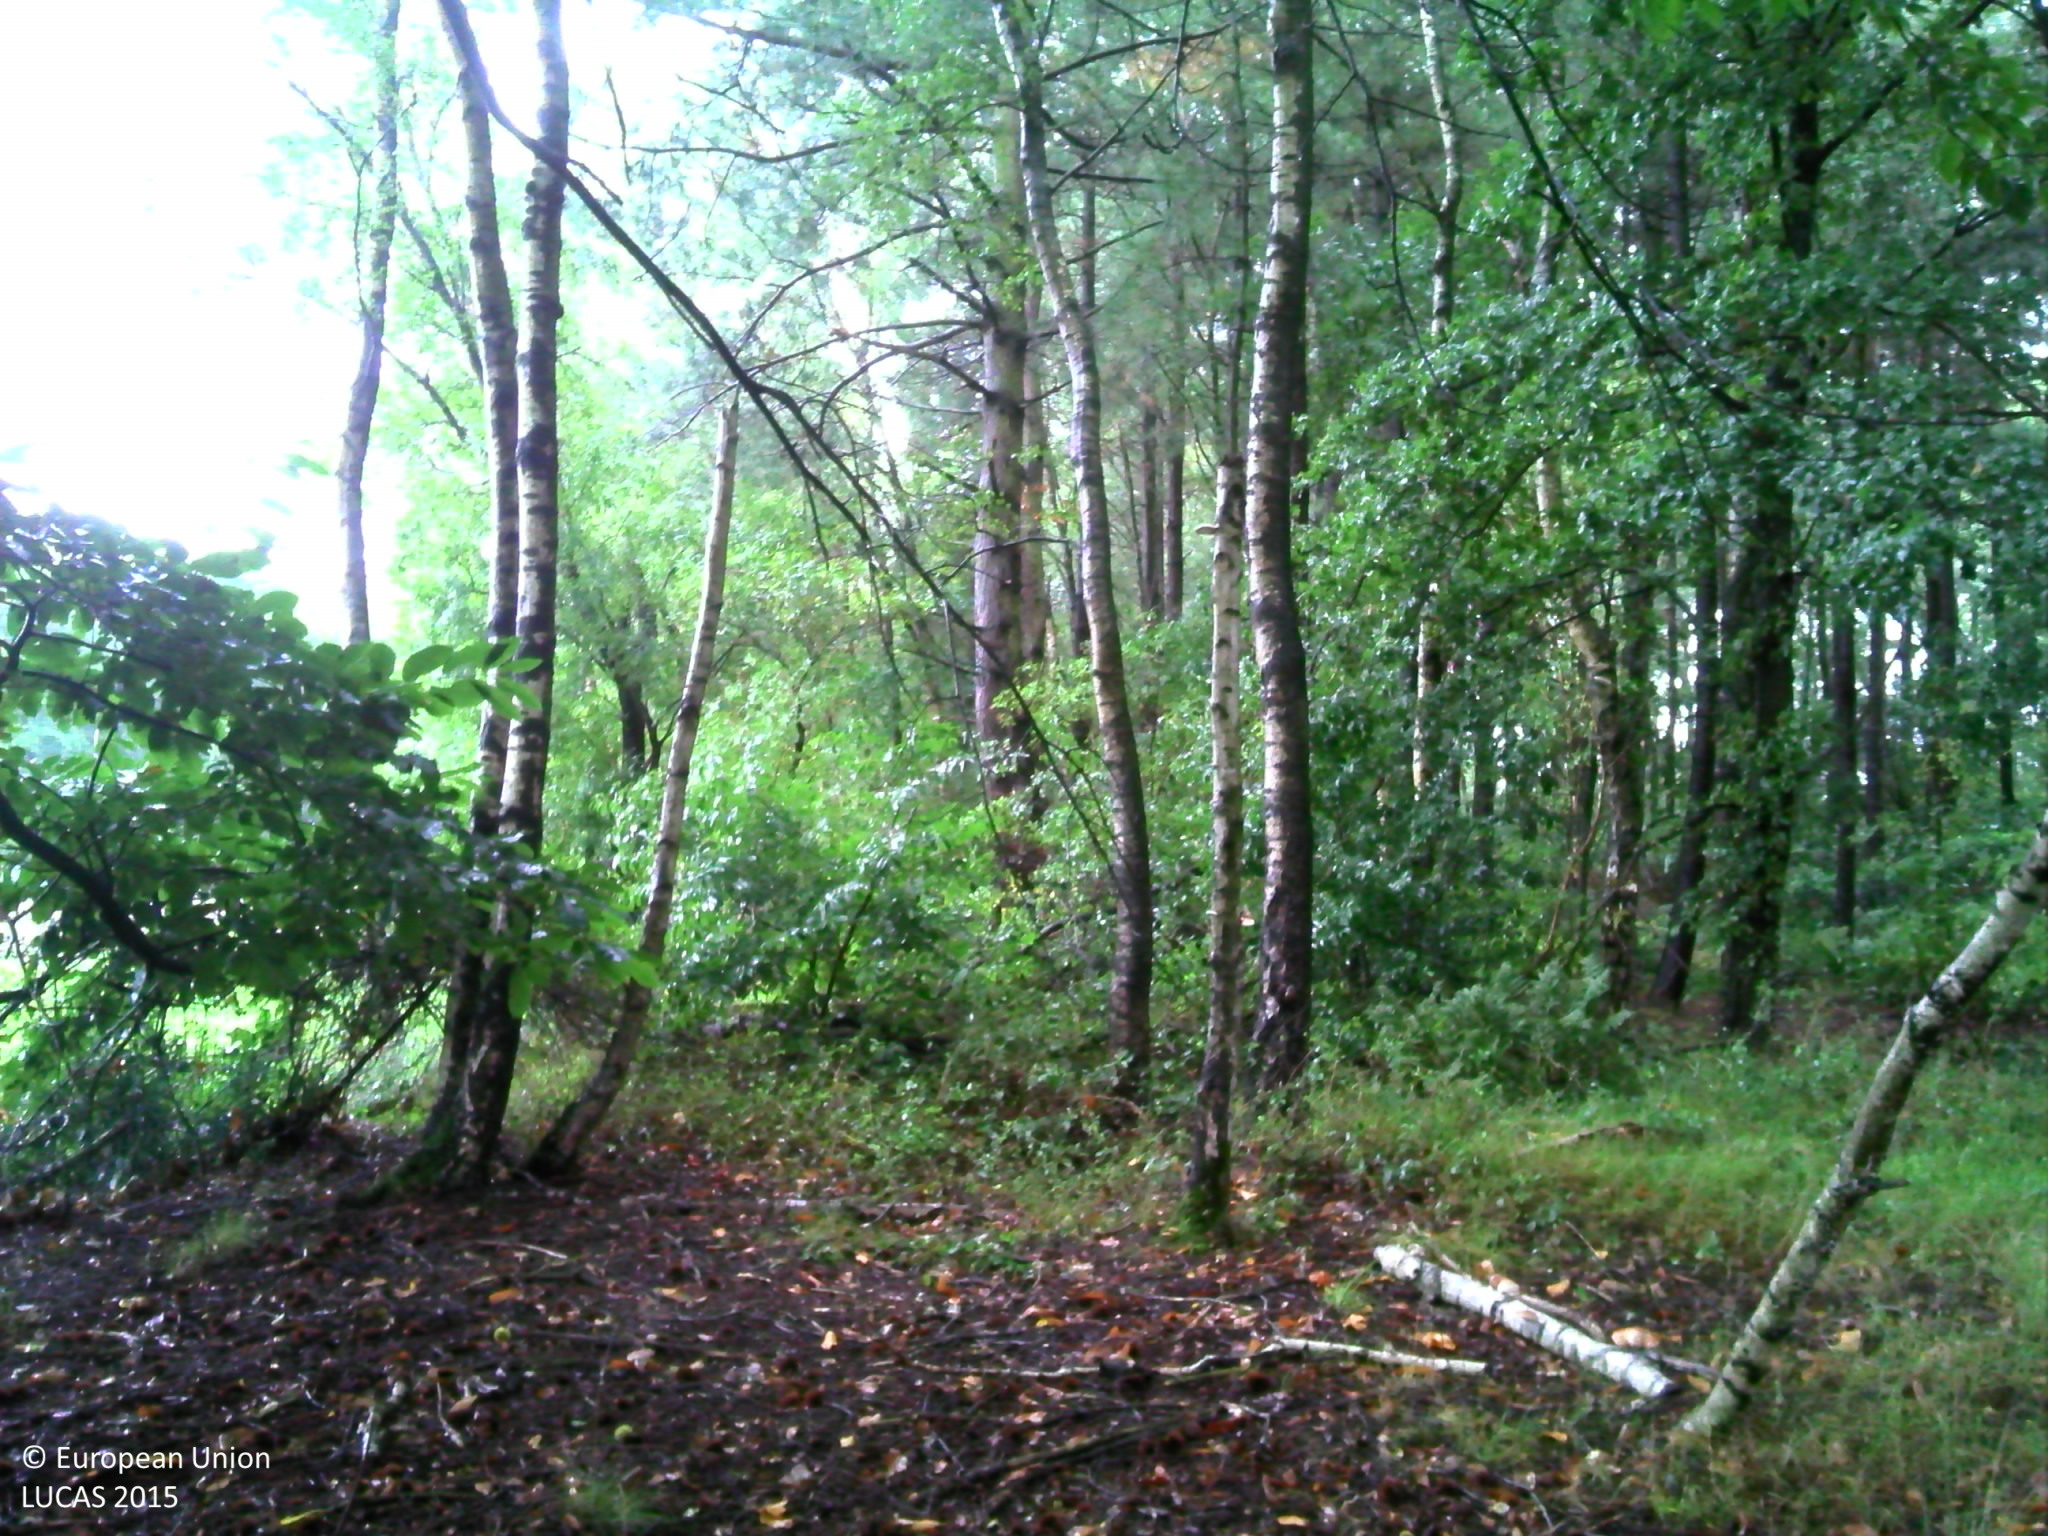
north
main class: Woodland
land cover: Broadleaved woodland
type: floodplain forest
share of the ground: > 75 %
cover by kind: broadleaved forest trees 80 %, herbaceous plants 20 %
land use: Forestry
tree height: > 5 m
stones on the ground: < 10 %
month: September
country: BE
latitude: 51.3416
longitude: 4.7279
